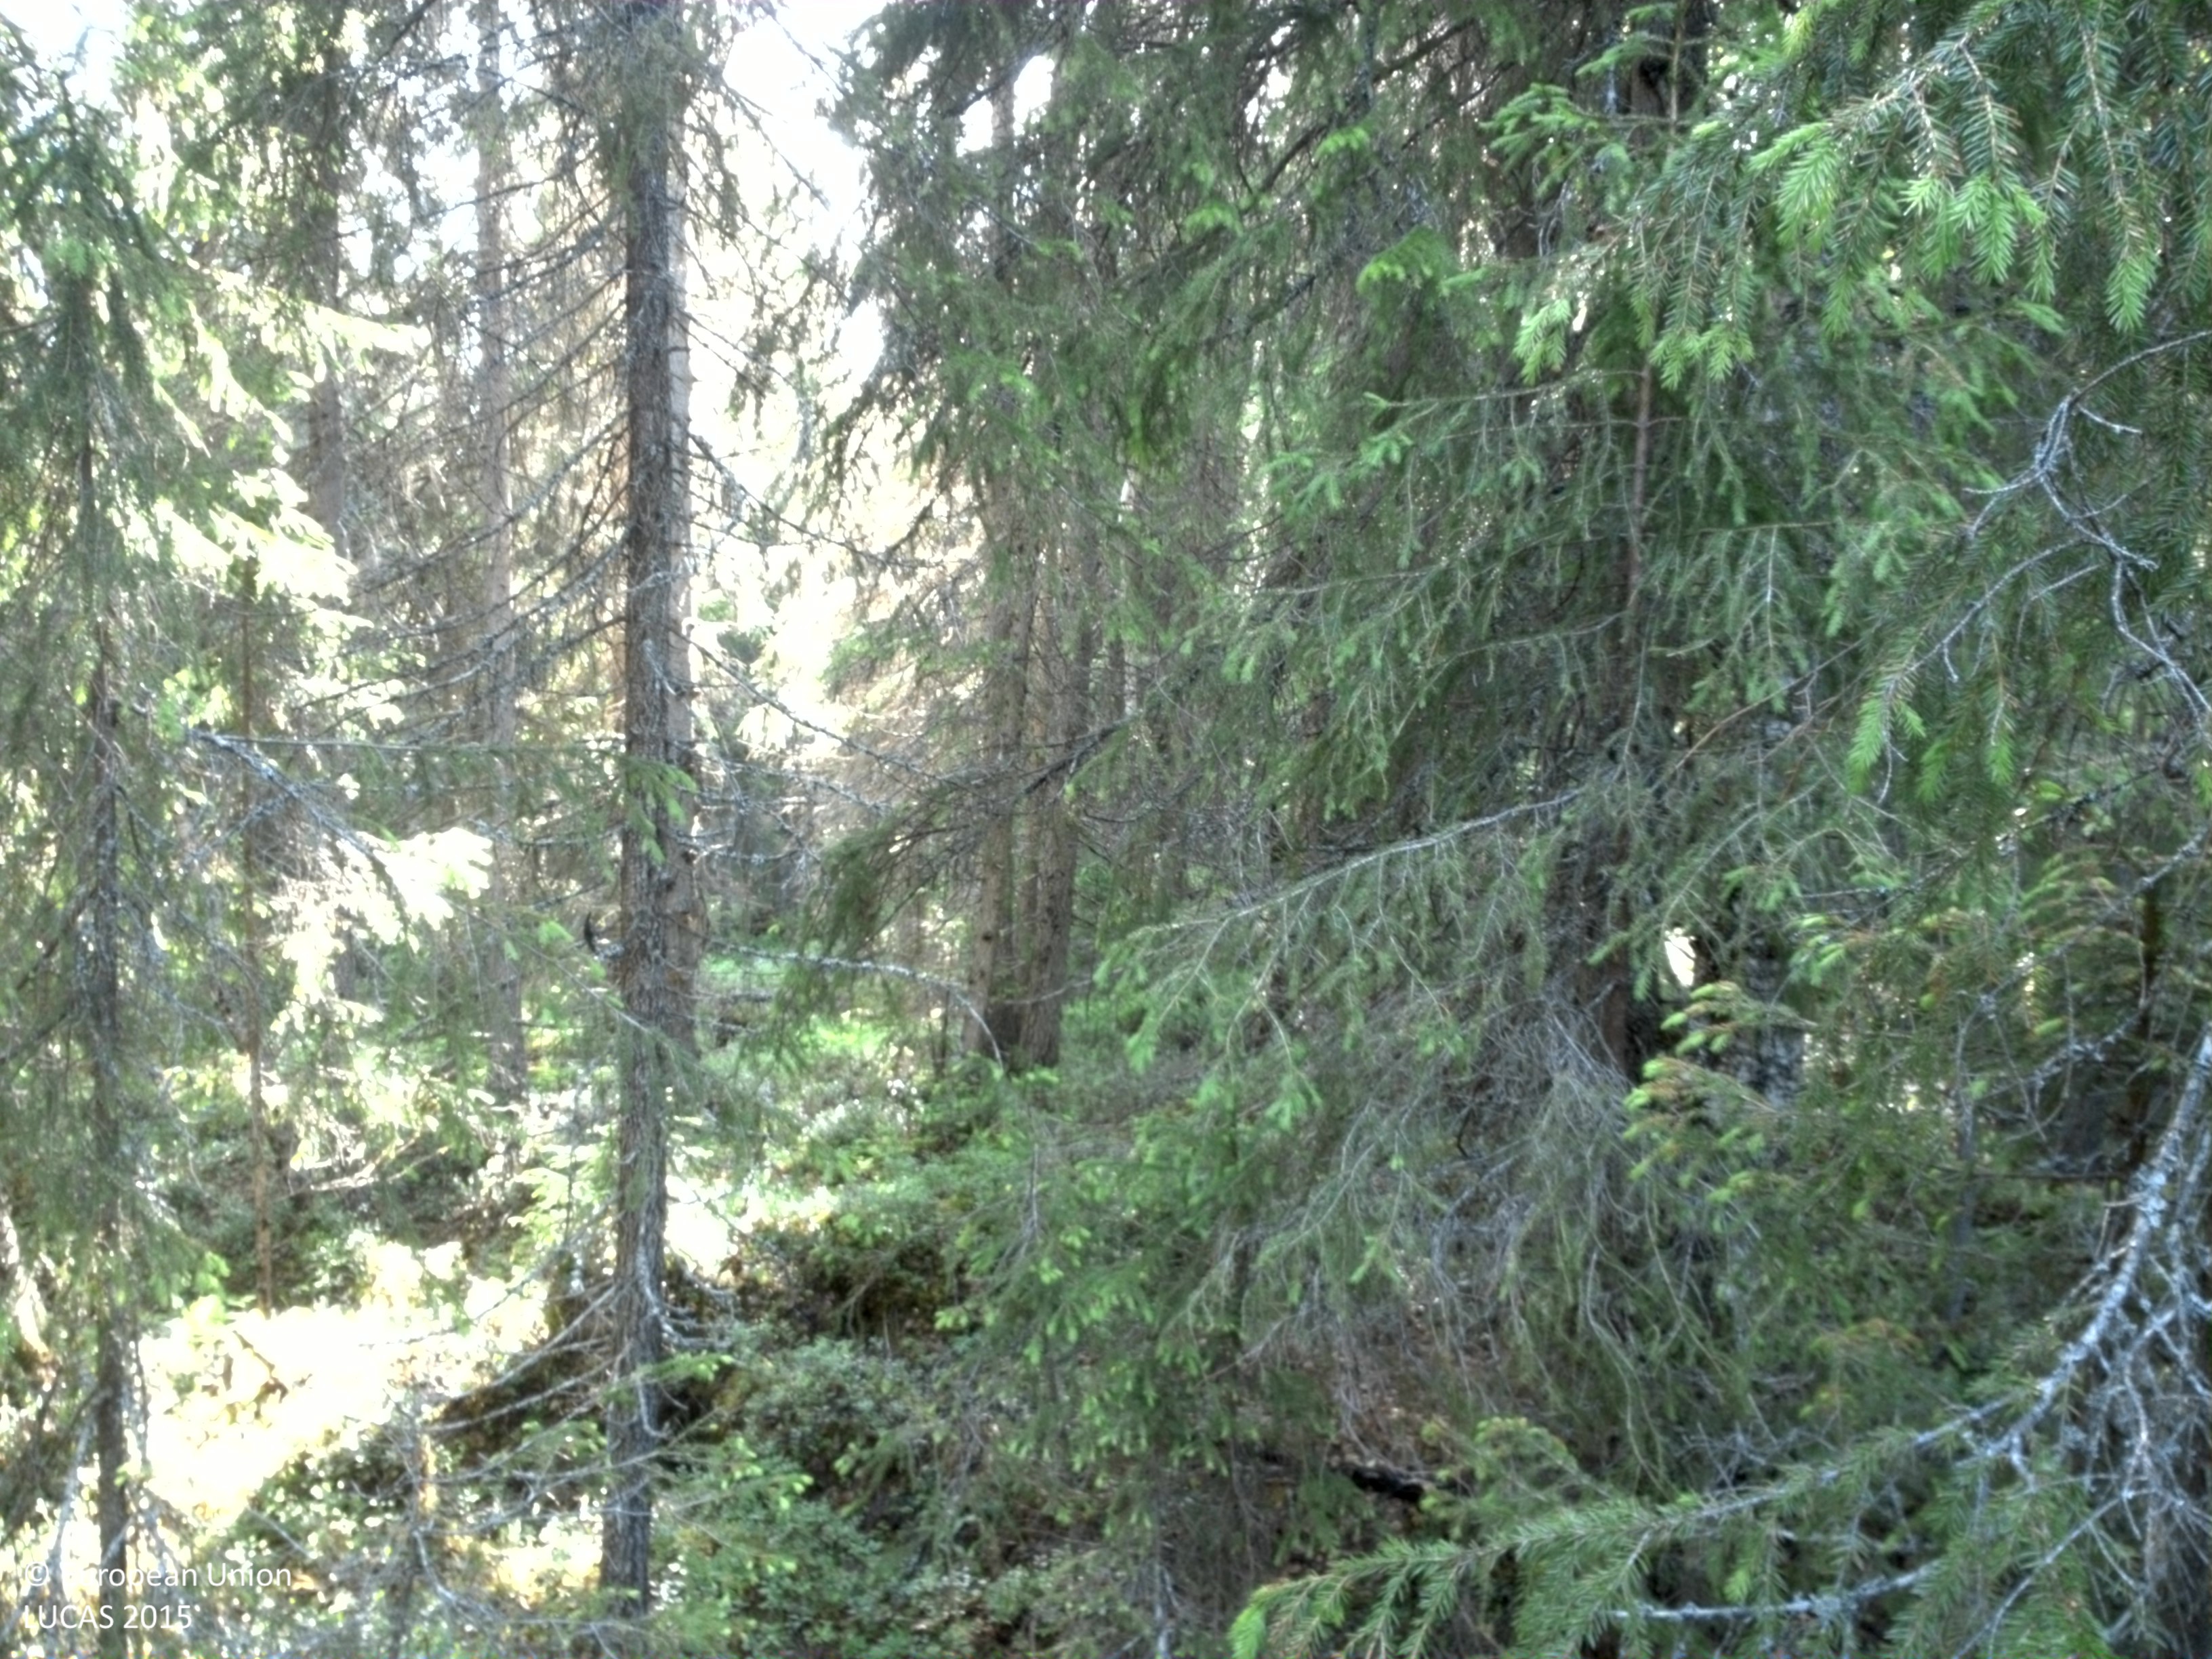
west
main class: Woodland
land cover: Spruce dominated coniferous woodland
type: boreal forest
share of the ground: 25 - 50 %
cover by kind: coniferous forest trees 40 %, shrubs 30 %, lichens and mosses 15 %, herbaceous plants 10 %, broadleaved forest trees 5 %
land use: Forestry
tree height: > 5 m
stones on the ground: < 10 %
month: July
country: SE
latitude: 65.5559
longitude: 15.4008
